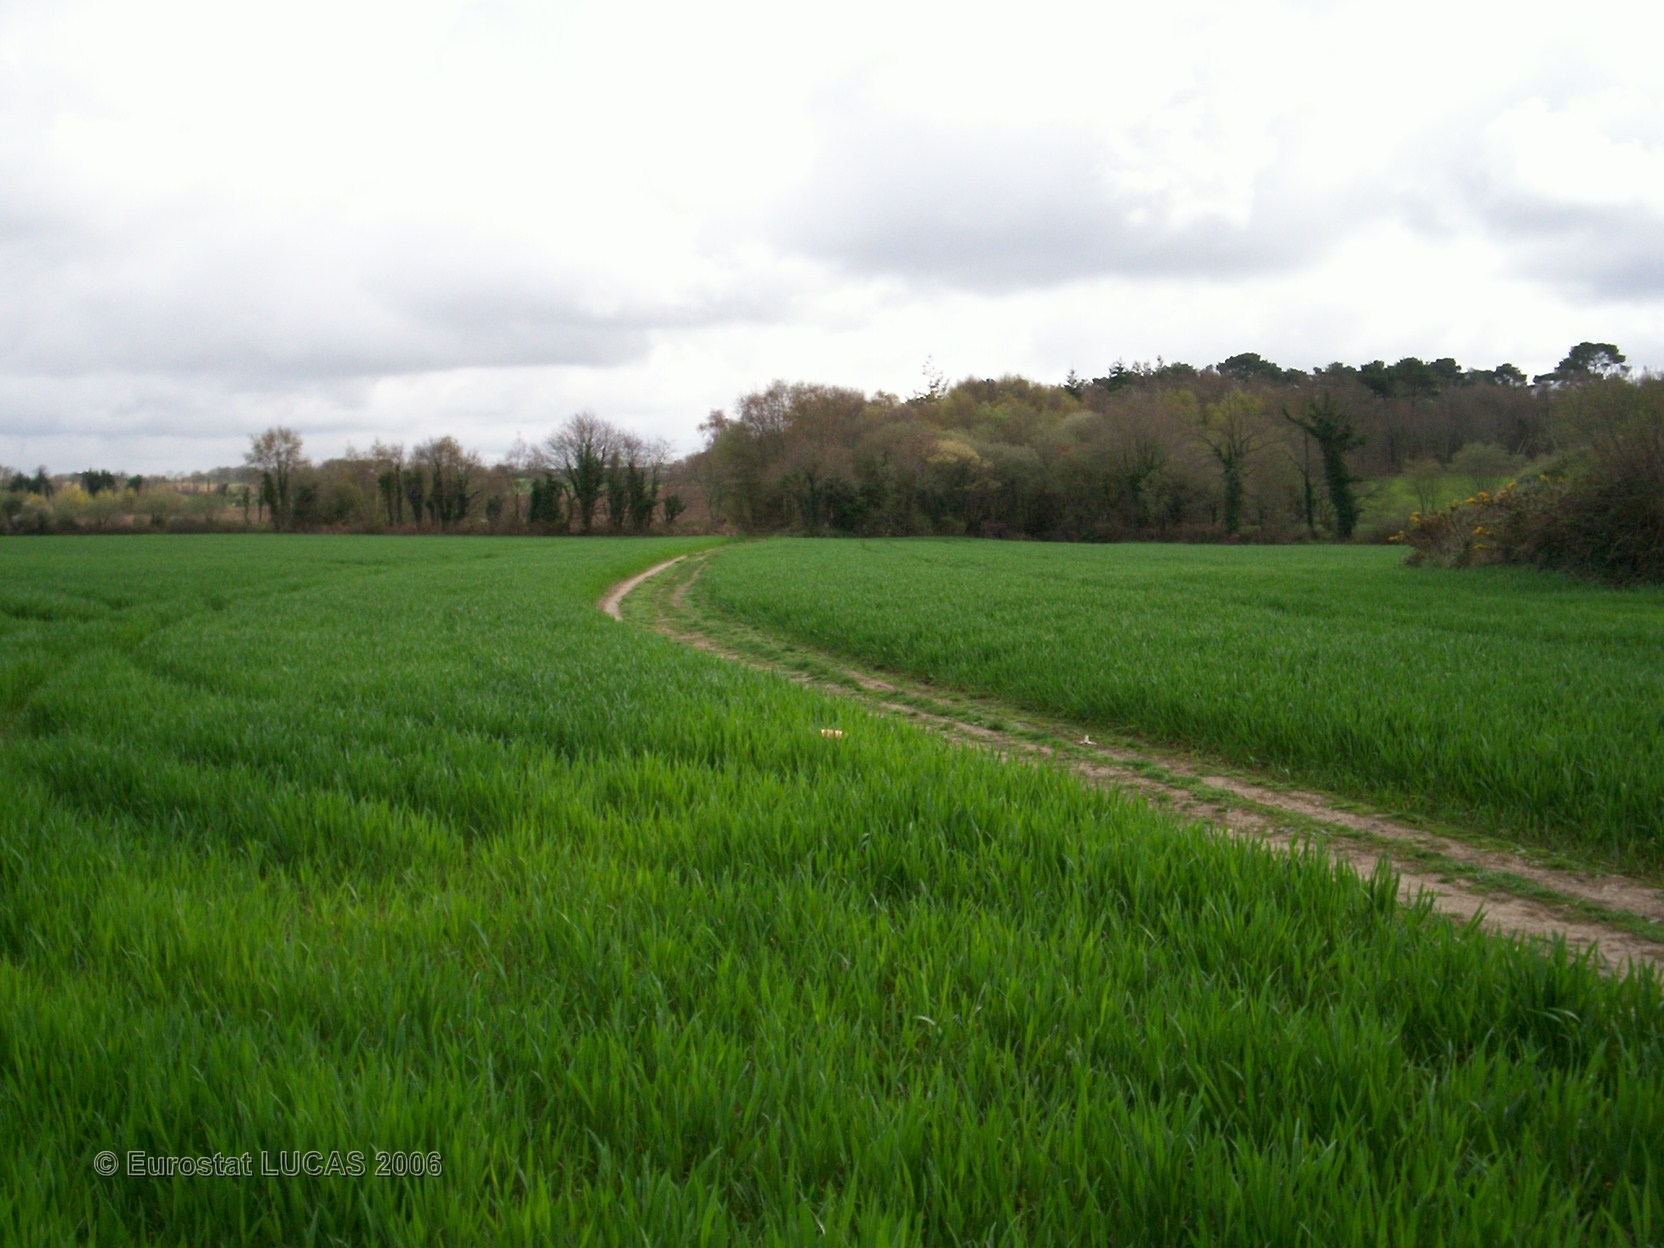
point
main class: Cropland
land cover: Triticale
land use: Agriculture (excluding fallow land and kitchen gardens)
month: April
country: FR
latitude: 47.7412
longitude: -3.4505
